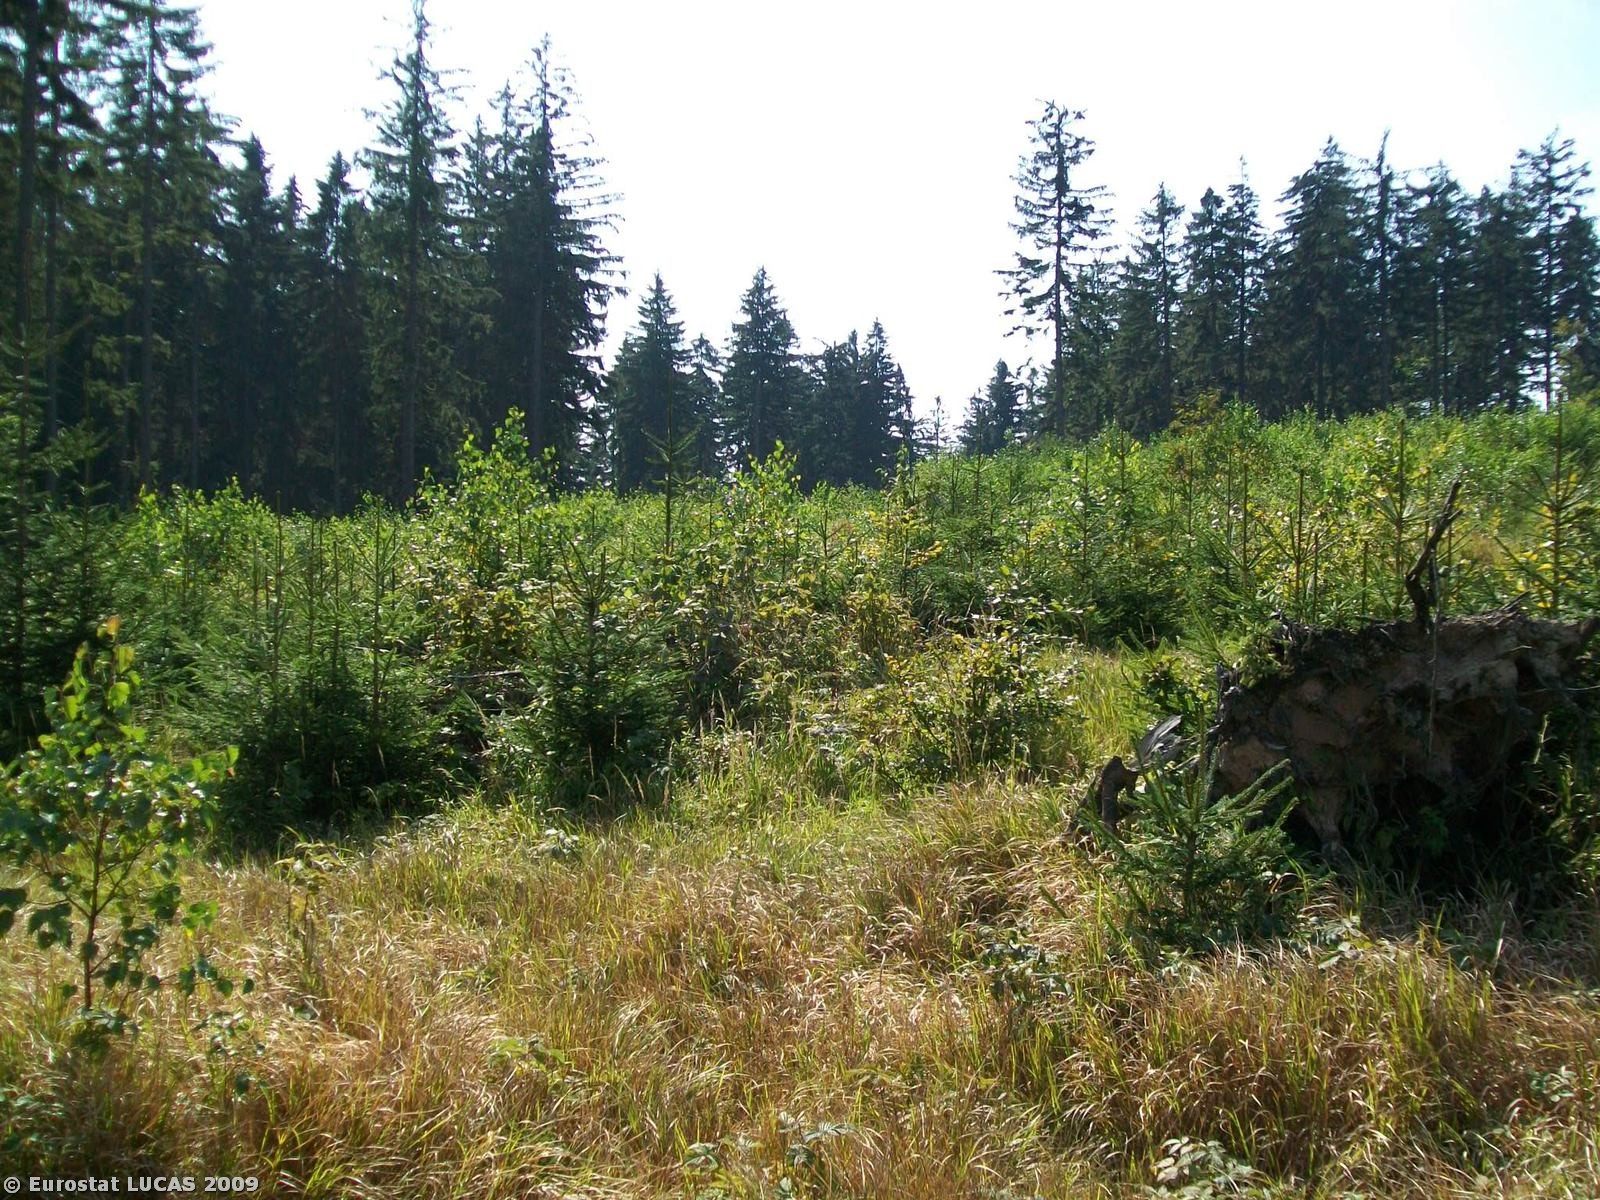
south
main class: Woodland
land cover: Mixed woodland
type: hemiboreal forest and nemoral coniferous forest and mixed broadleaved-coniferous forest
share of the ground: 50 - 75 %
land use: Forestry
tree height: > 5 m
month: September
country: PL
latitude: 50.1732
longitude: 16.6028
